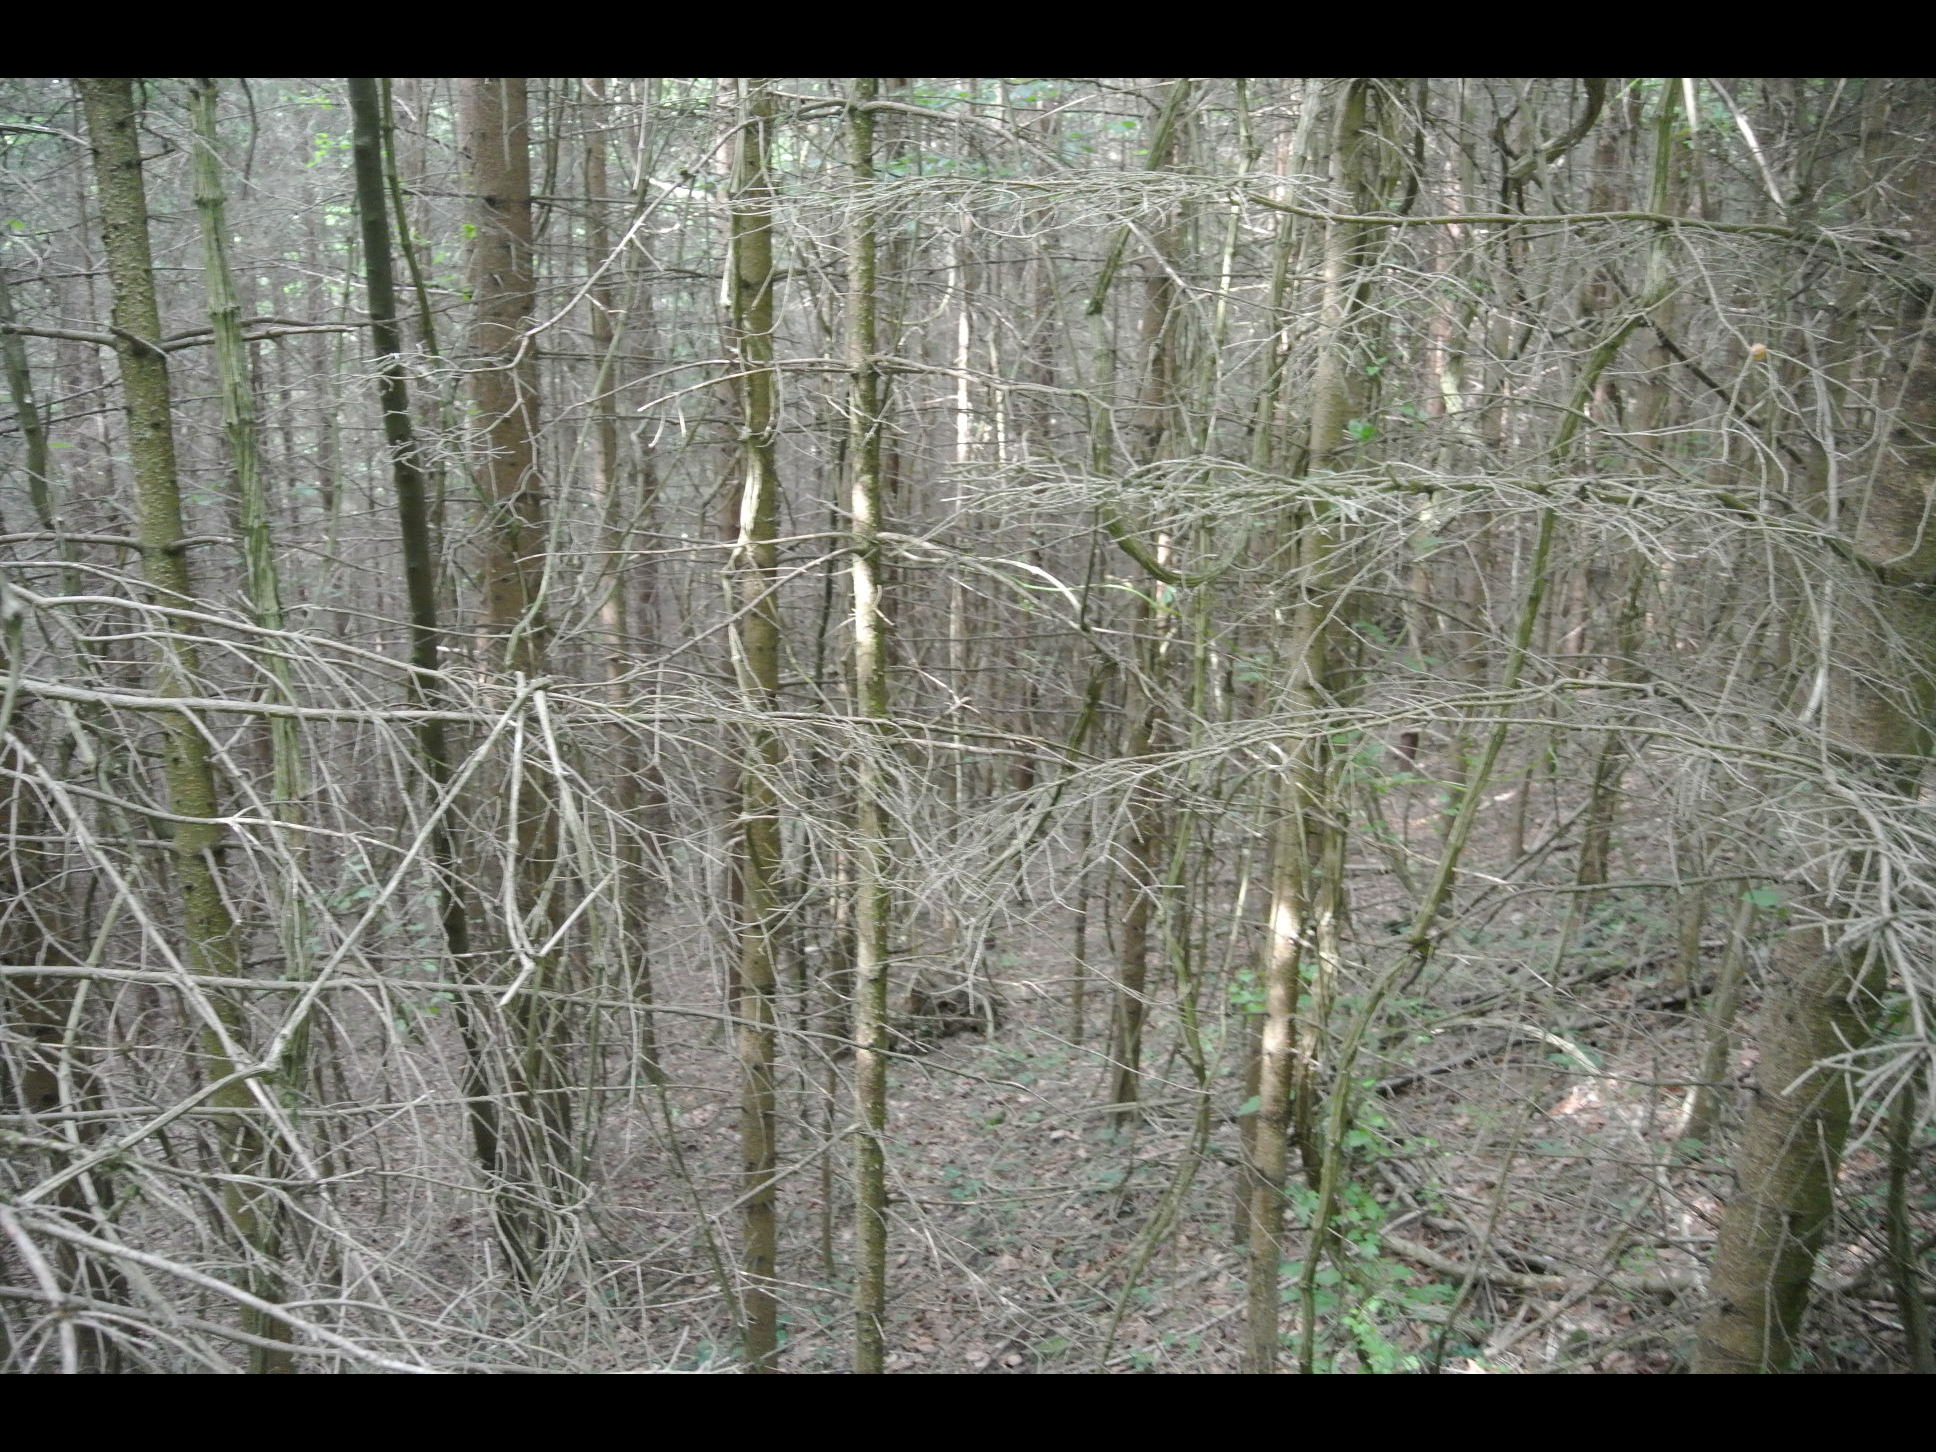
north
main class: Woodland
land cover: Spruce dominated coniferous woodland
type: alpine coniferous forest
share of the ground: > 75 %
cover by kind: coniferous forest trees 100 %
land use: Forestry
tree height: > 5 m
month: May
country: AT
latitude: 47.9833
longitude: 15.7504
